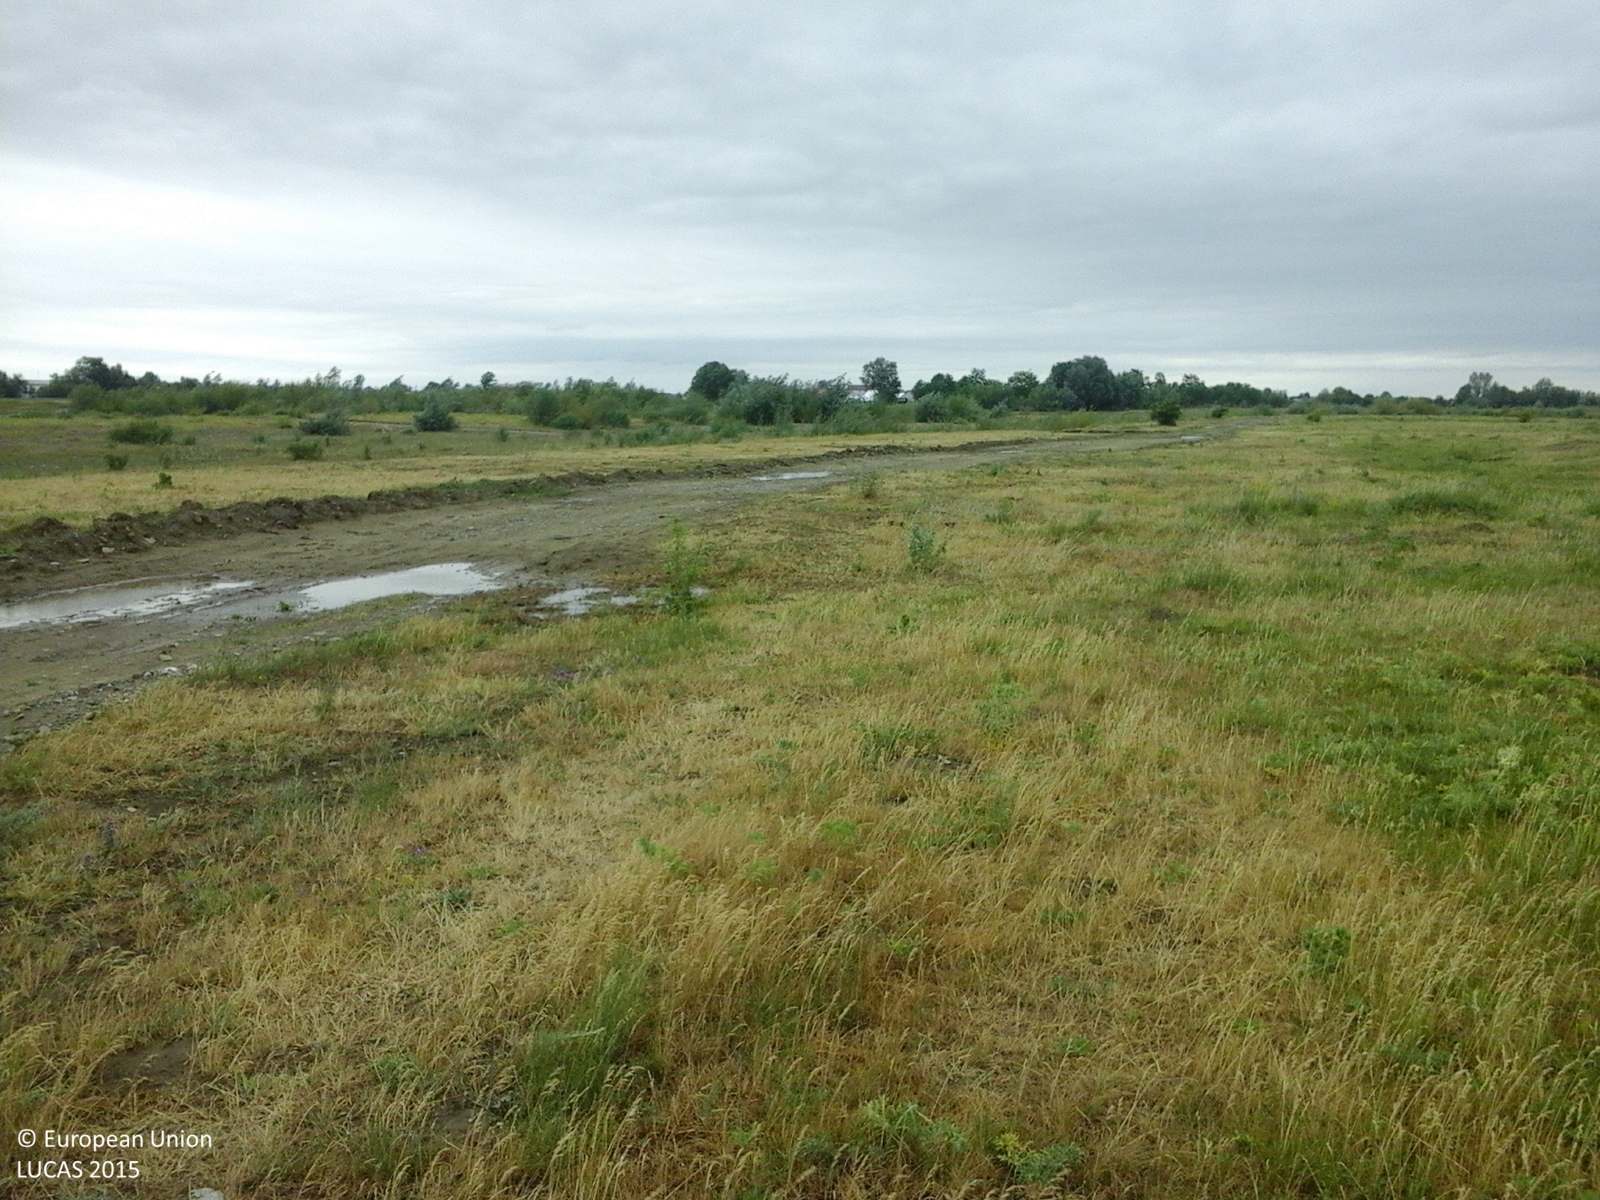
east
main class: Grassland
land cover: Grassland without tree/shrub cover
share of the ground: > 75 %
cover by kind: herbaceous plants 100 %
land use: Agriculture (excluding fallow land and kitchen gardens)
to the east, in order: Grassland without tree/shrub cover; Tracks; Grassland without tree/shrub cover; Spontaneously vegetated surfaces; Tracks; Rocks and stones; Shrubland with sparse tree cover; Spontaneously vegetated surfaces
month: June
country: RO
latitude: 47.4207
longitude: 26.1851
